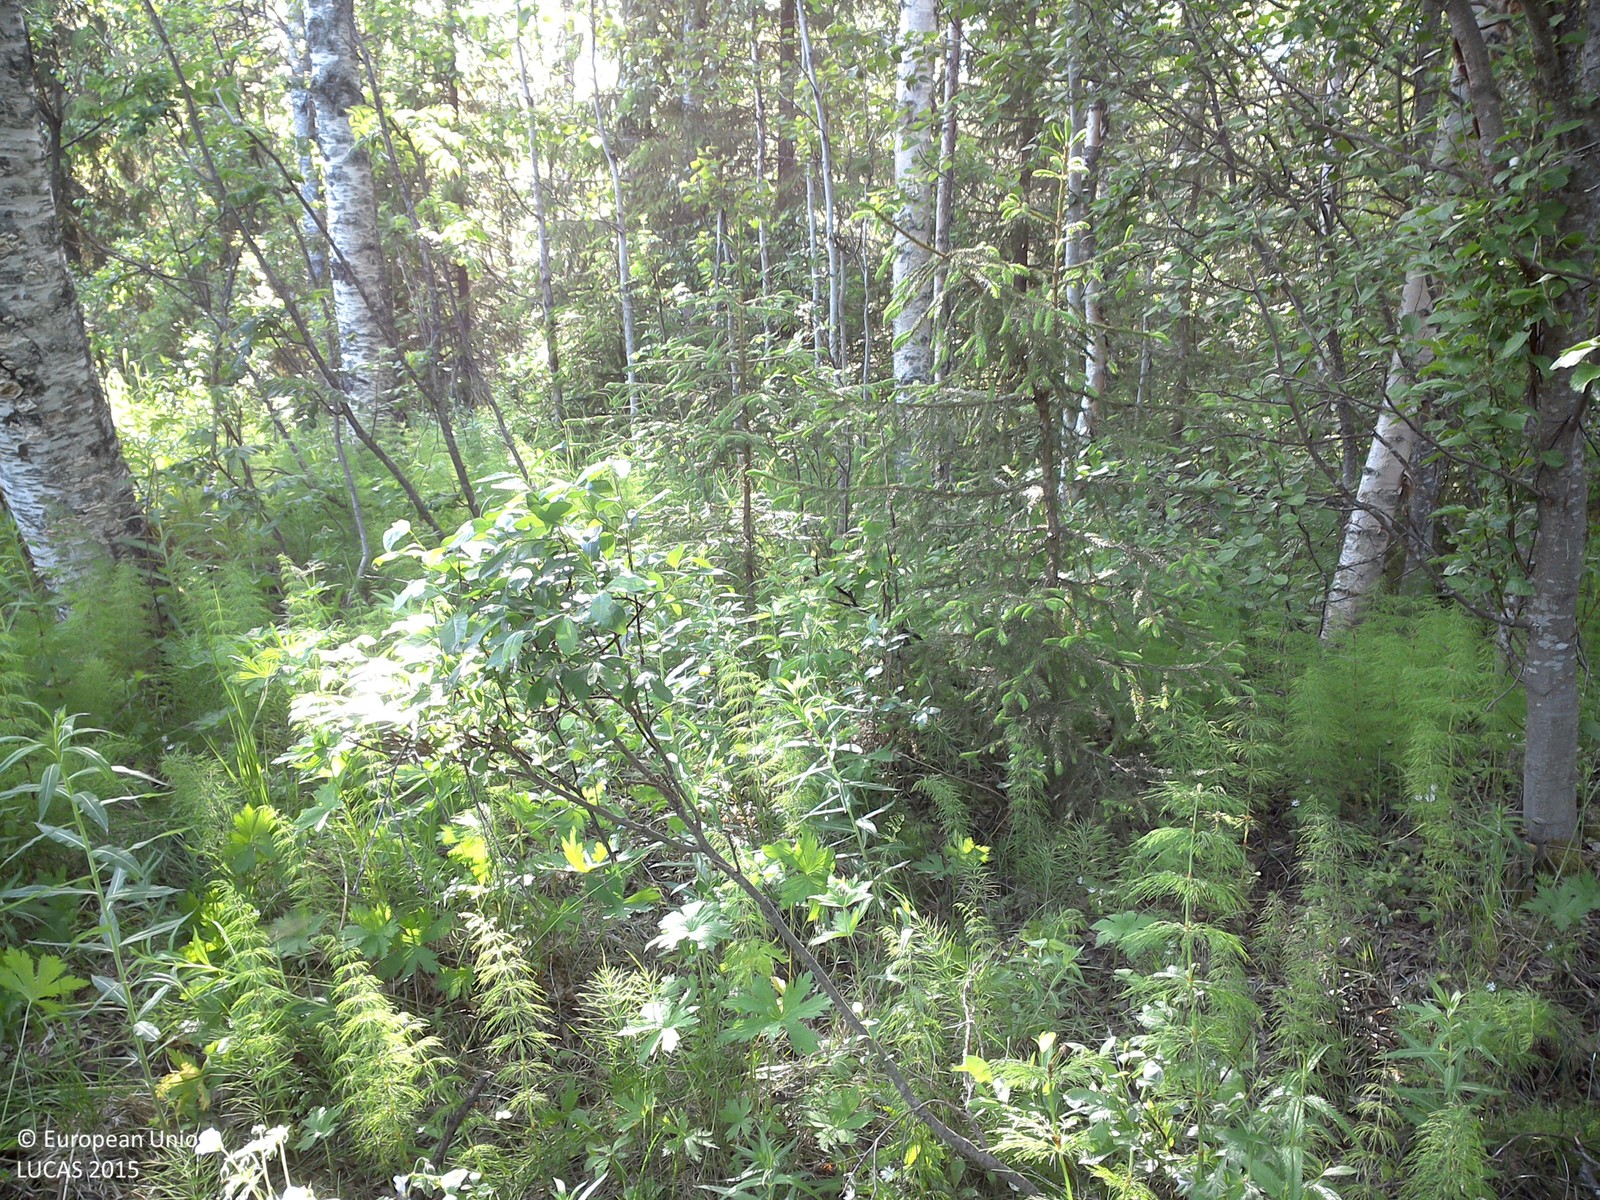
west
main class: Woodland
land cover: Broadleaved woodland
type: boreal forest
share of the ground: 25 - 50 %
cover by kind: herbaceous plants 45 %, broadleaved forest trees 40 %, shrubs 10 %, coniferous forest trees 5 %
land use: Residential
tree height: > 5 m
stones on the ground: 10 - 25 %
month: June
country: SE
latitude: 66.7902
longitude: 22.9108
